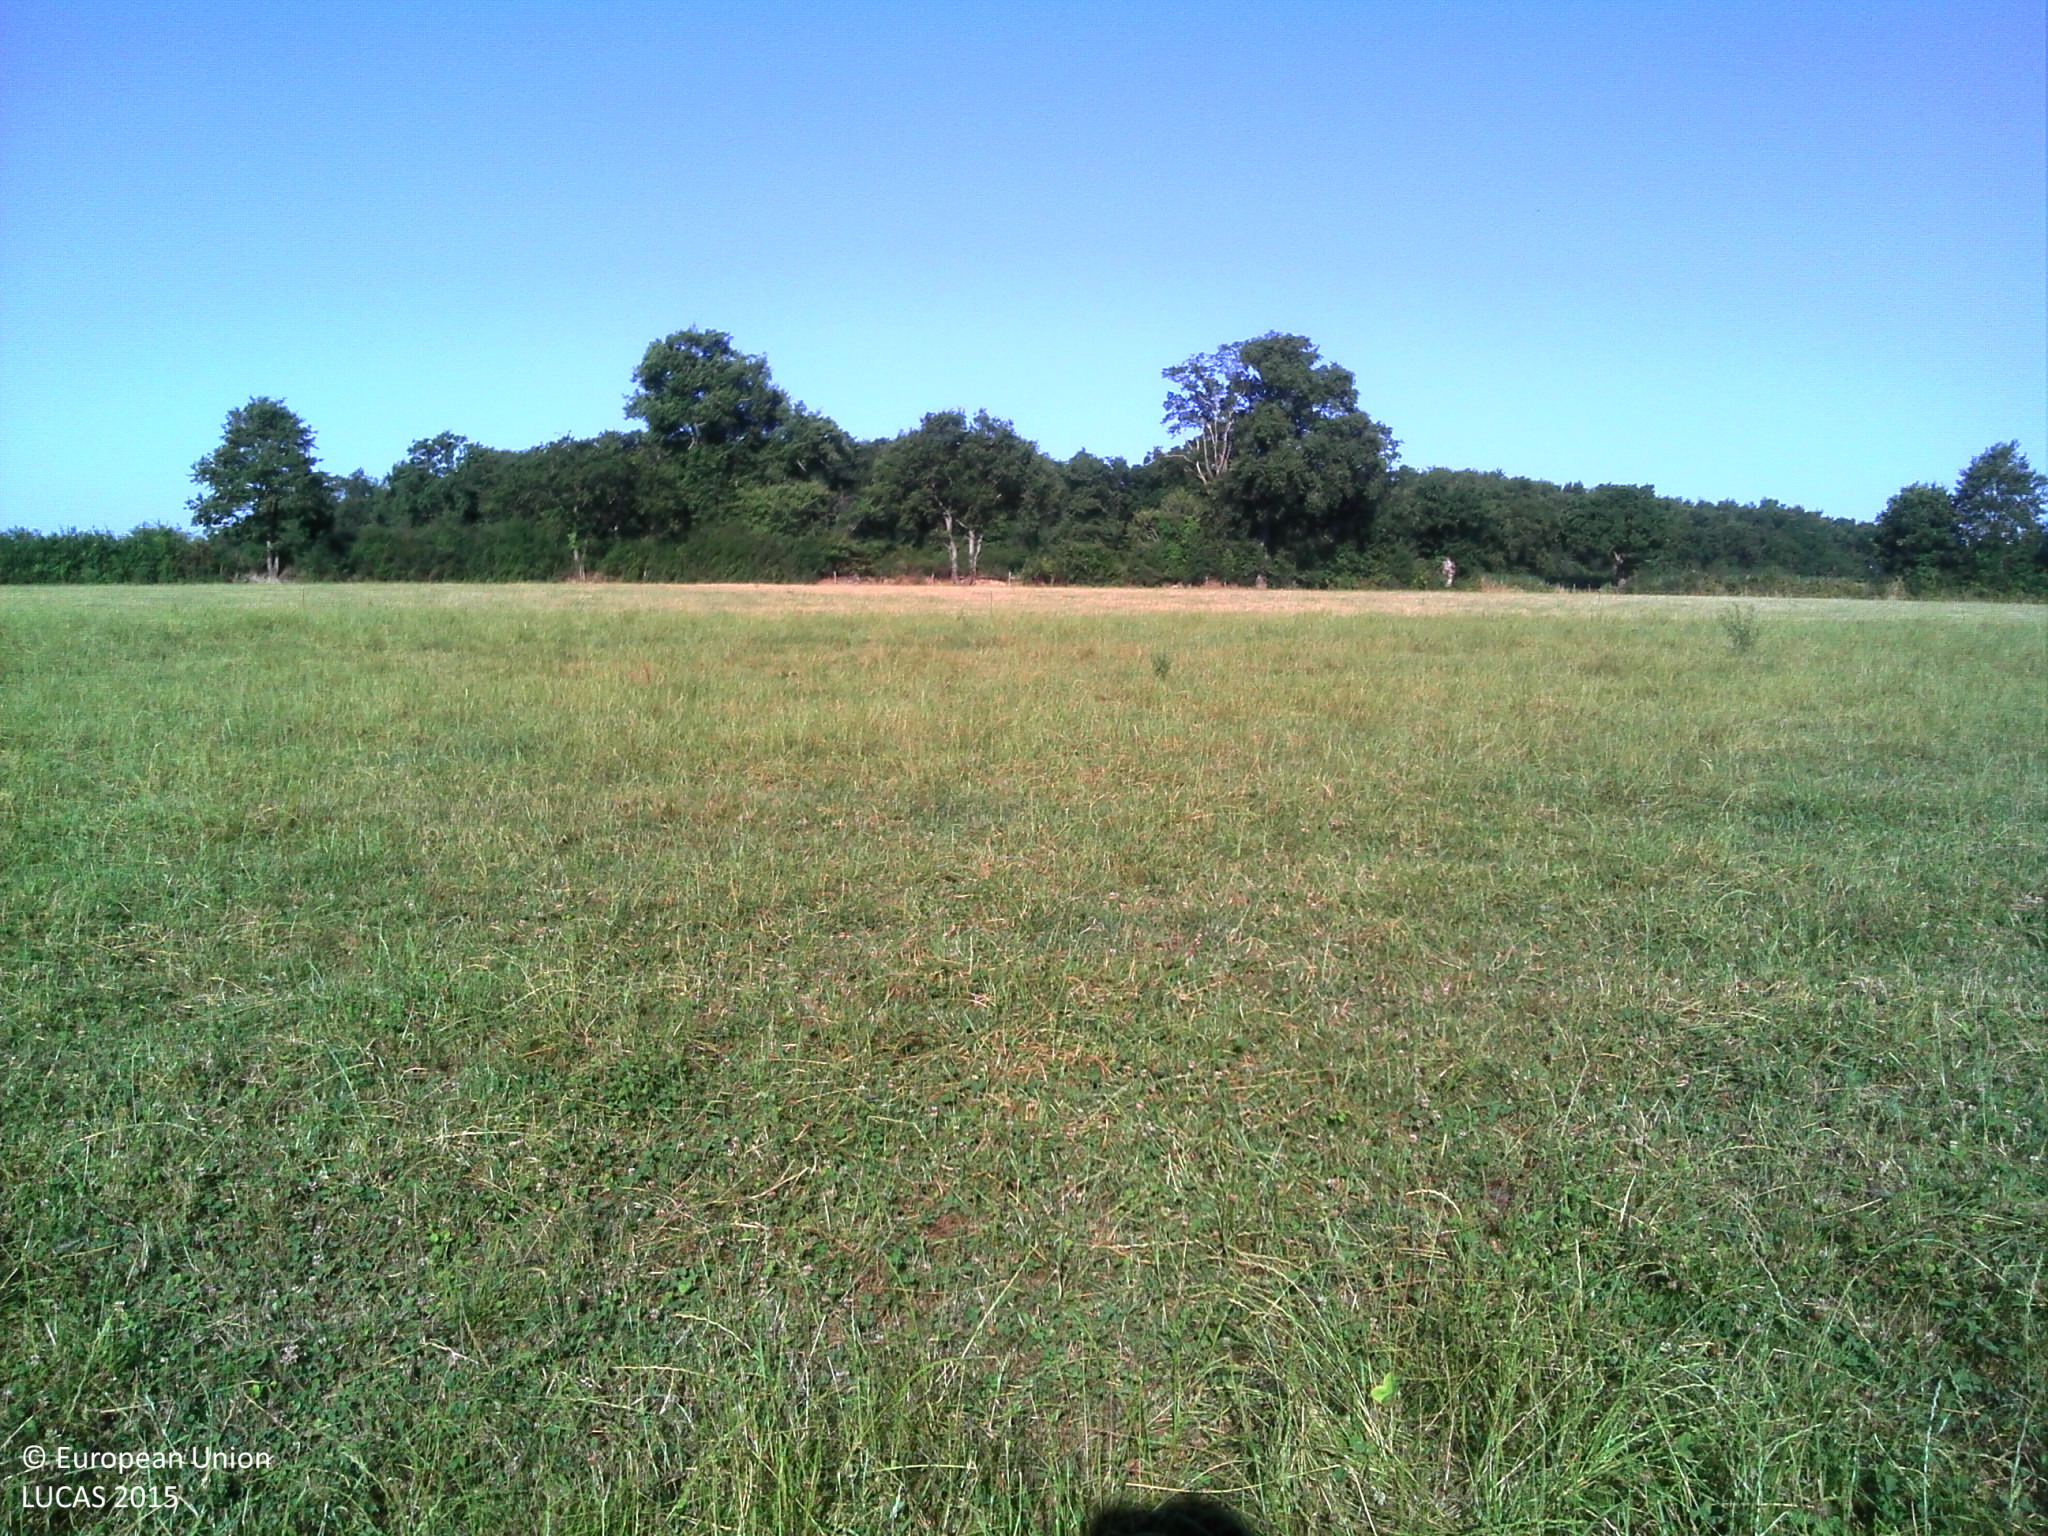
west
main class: Cropland
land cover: Temporary grasslands
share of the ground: > 75 %
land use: Agriculture (excluding fallow land and kitchen gardens)
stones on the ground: < 10 %
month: July
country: FR
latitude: 47.1249
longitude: -1.8700
